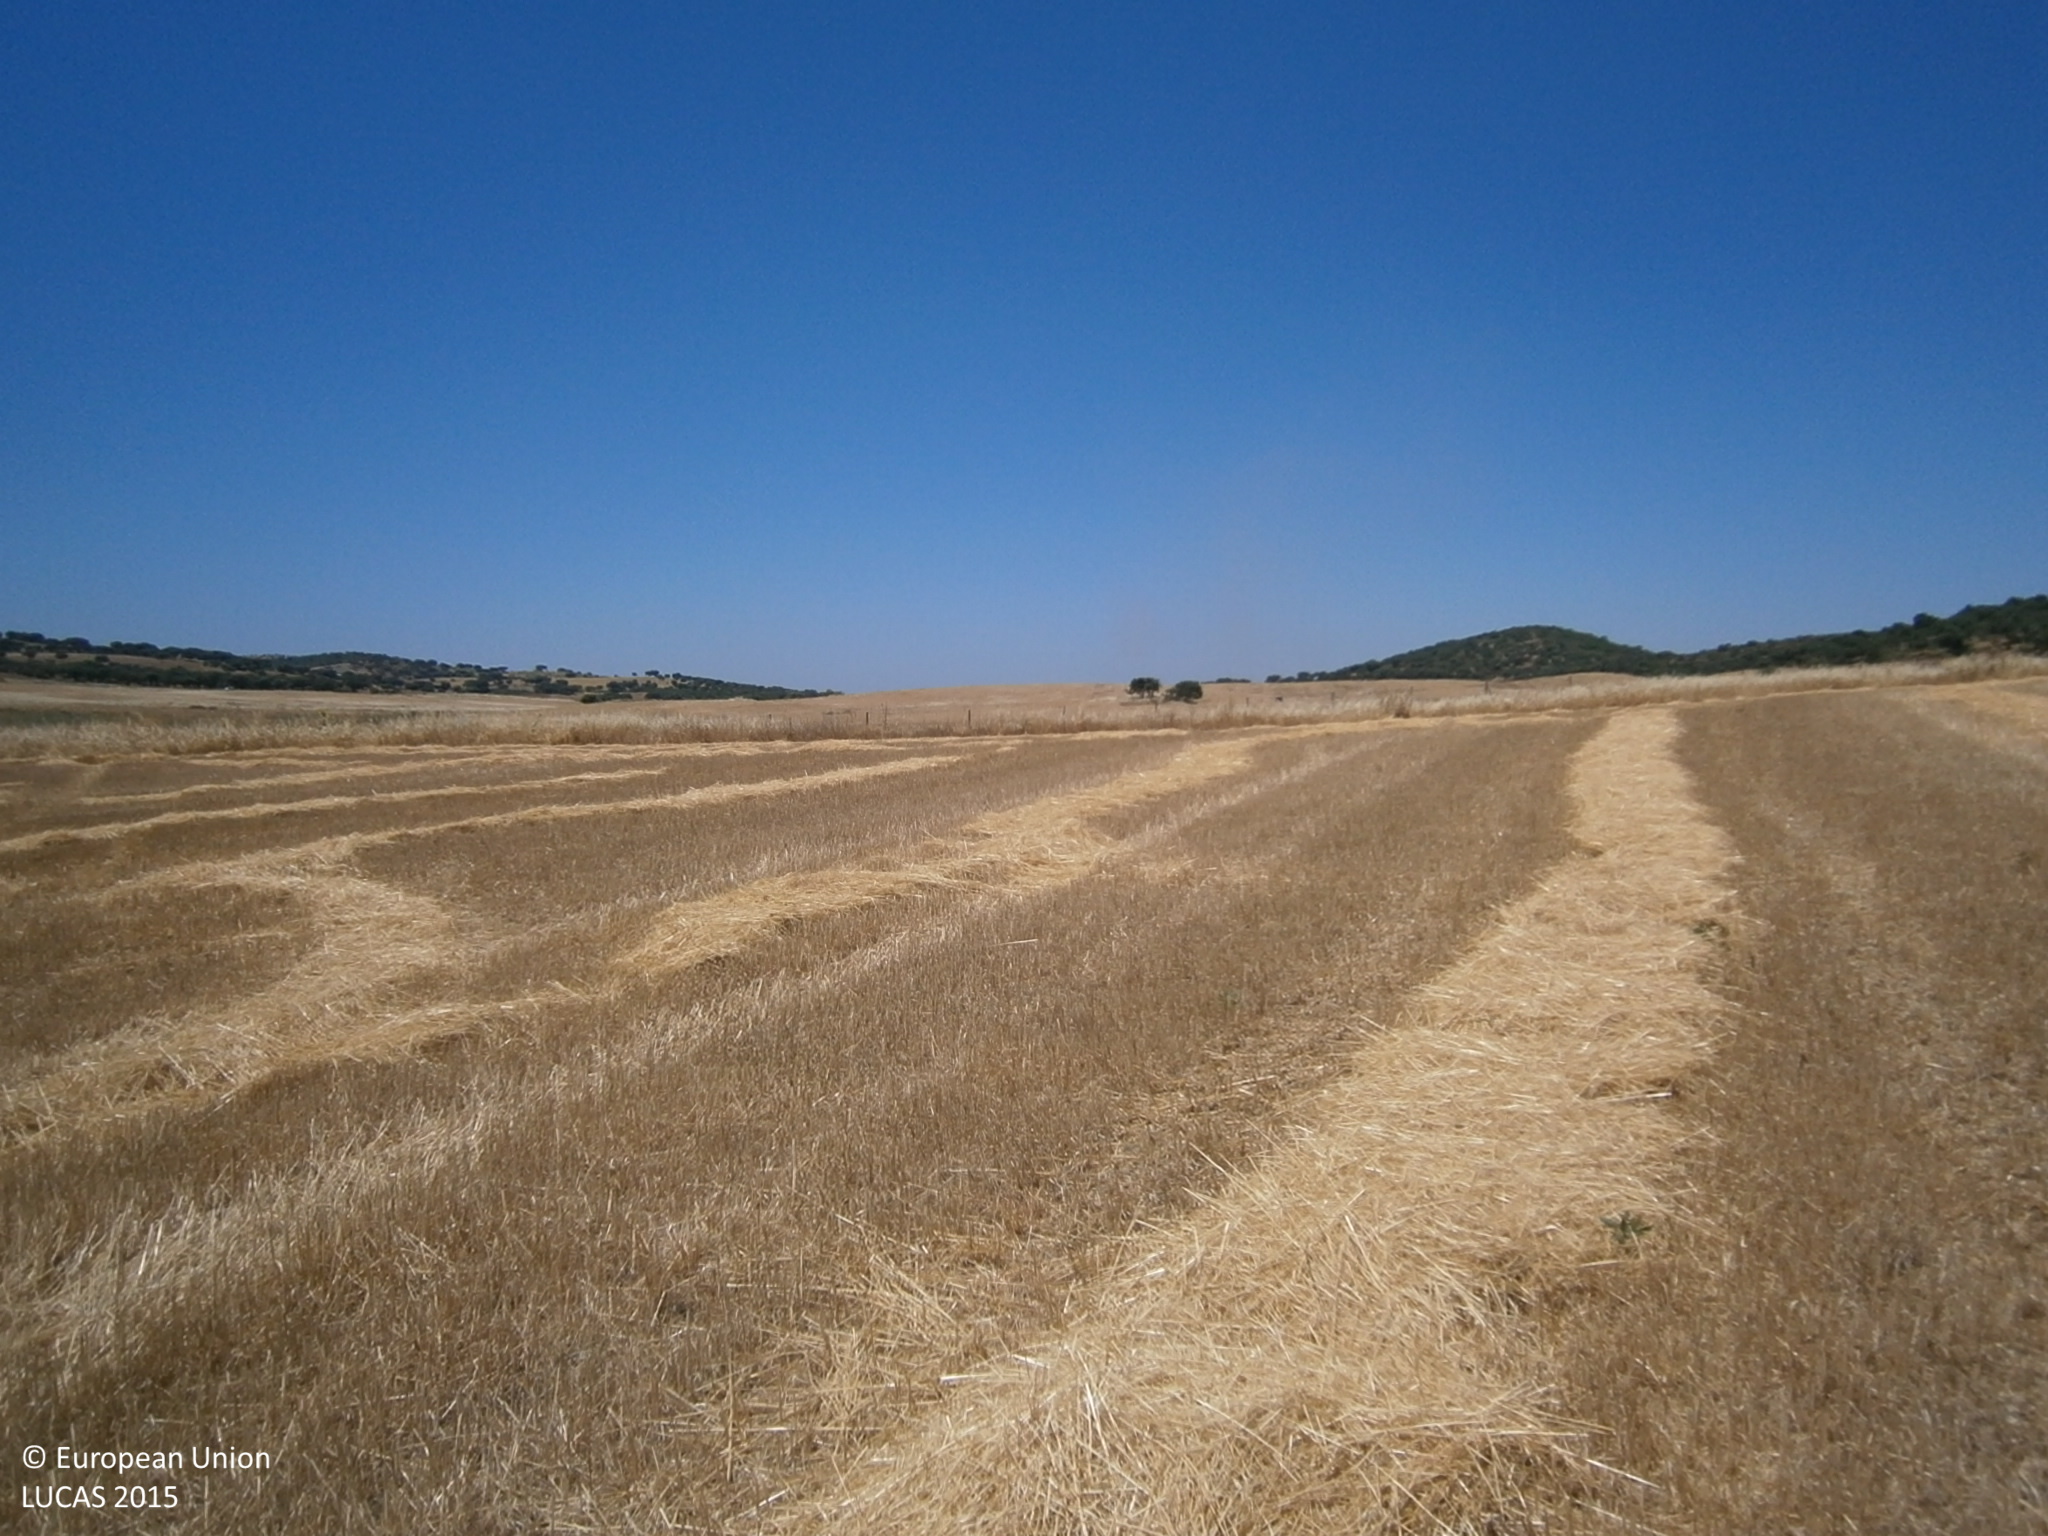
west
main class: Cropland
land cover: Oats
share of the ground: > 75 %
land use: Agriculture (excluding fallow land and kitchen gardens)
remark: Harvested field
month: June
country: ES
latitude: 38.6561
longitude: -6.9224
